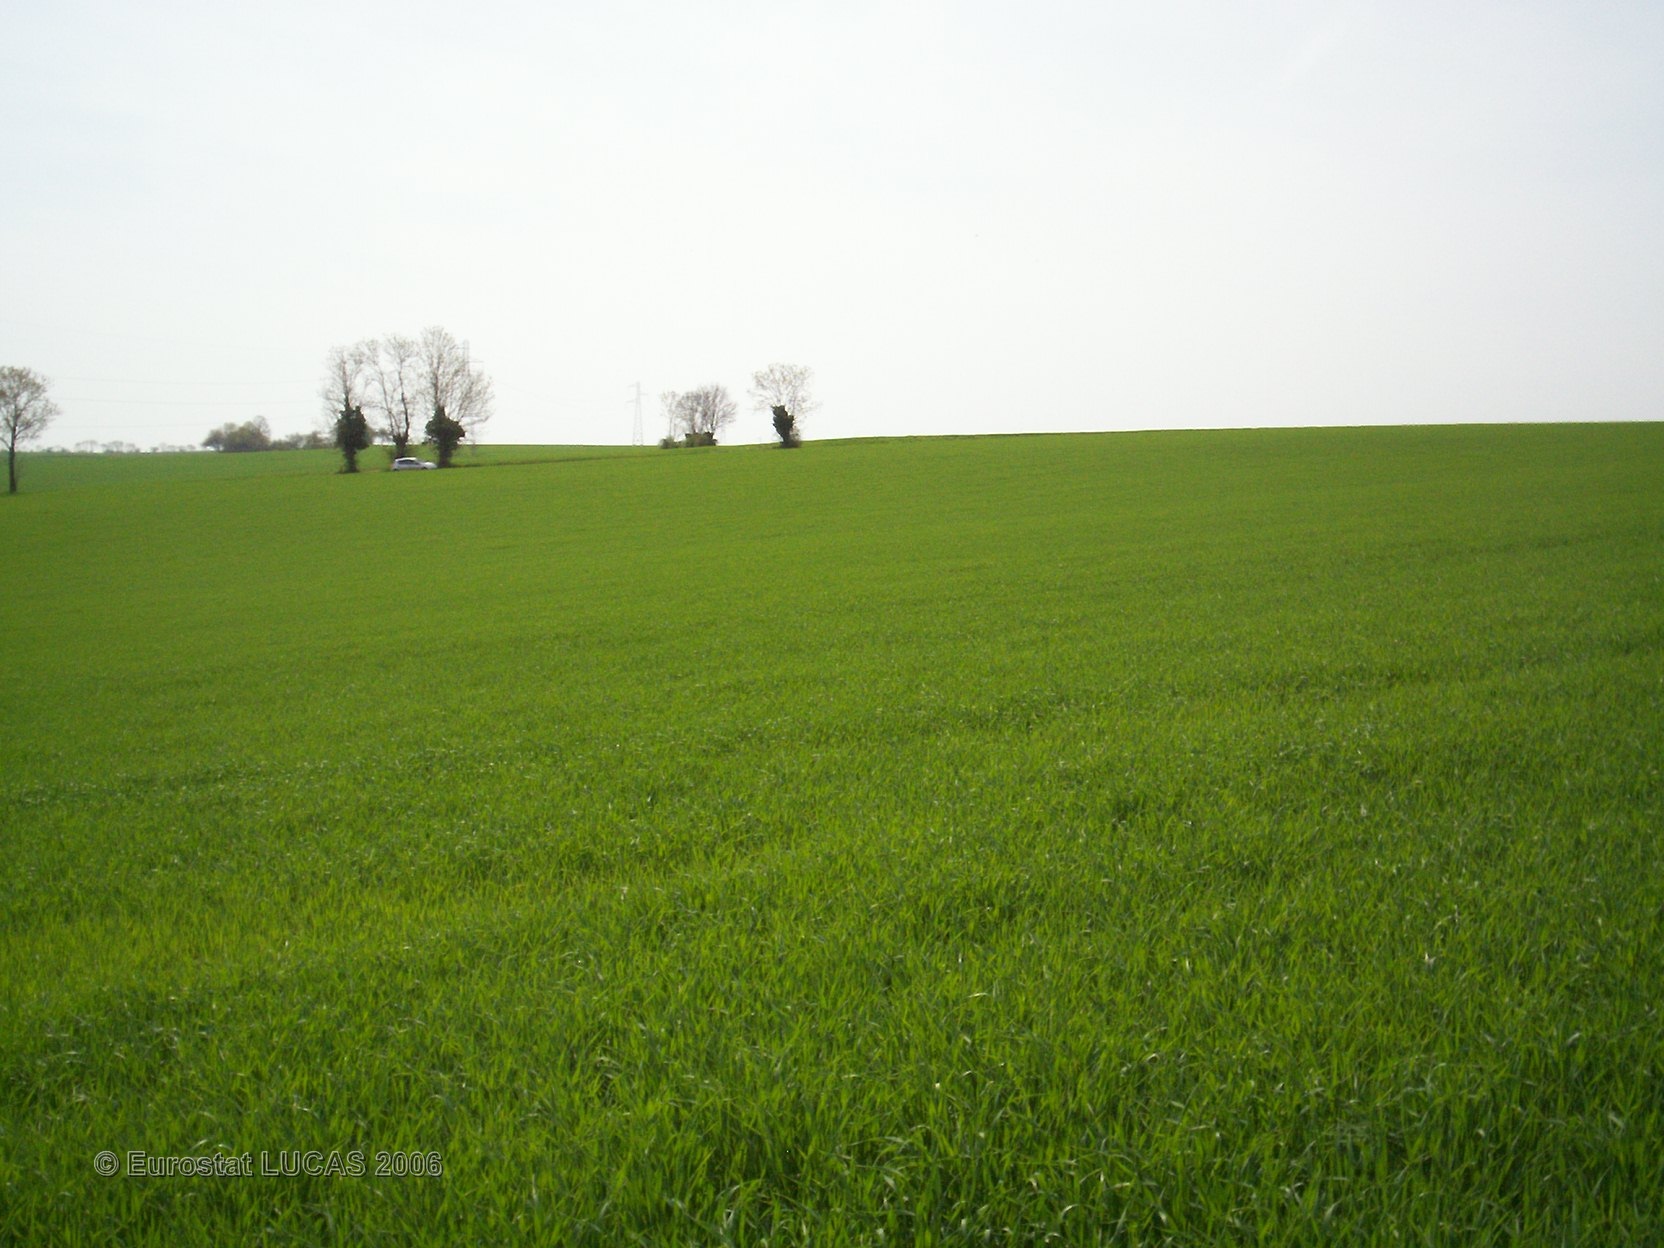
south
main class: Cropland
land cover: Barley
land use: Agriculture (excluding fallow land and kitchen gardens)
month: May
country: FR
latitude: 47.6188
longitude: 4.5305
